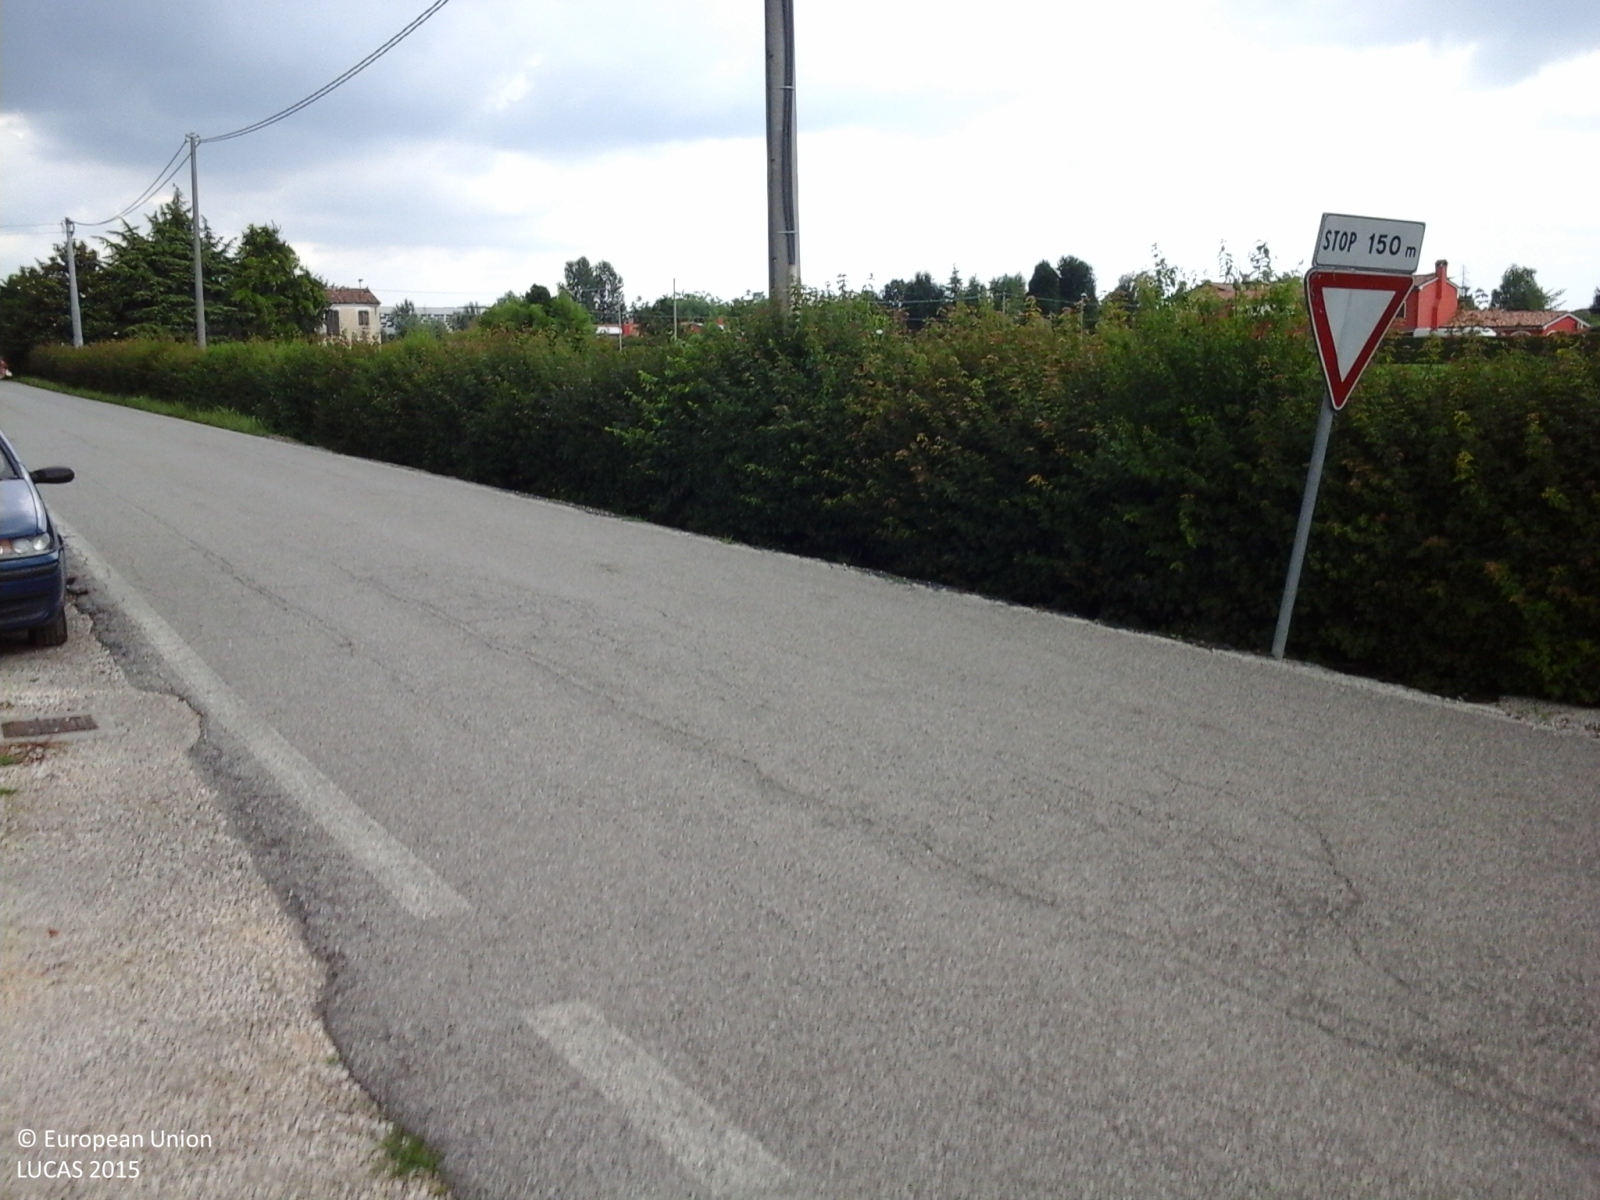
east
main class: Cropland
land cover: Potatoes
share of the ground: > 75 %
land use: Agriculture (excluding fallow land and kitchen gardens)
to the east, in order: Potatoes; Grassland without tree/shrub cover; Artificial constructions in urban areas; Maize; Managed hedges; Artificial constructions in urban areas
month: June
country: IT
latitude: 45.6719
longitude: 12.5509
